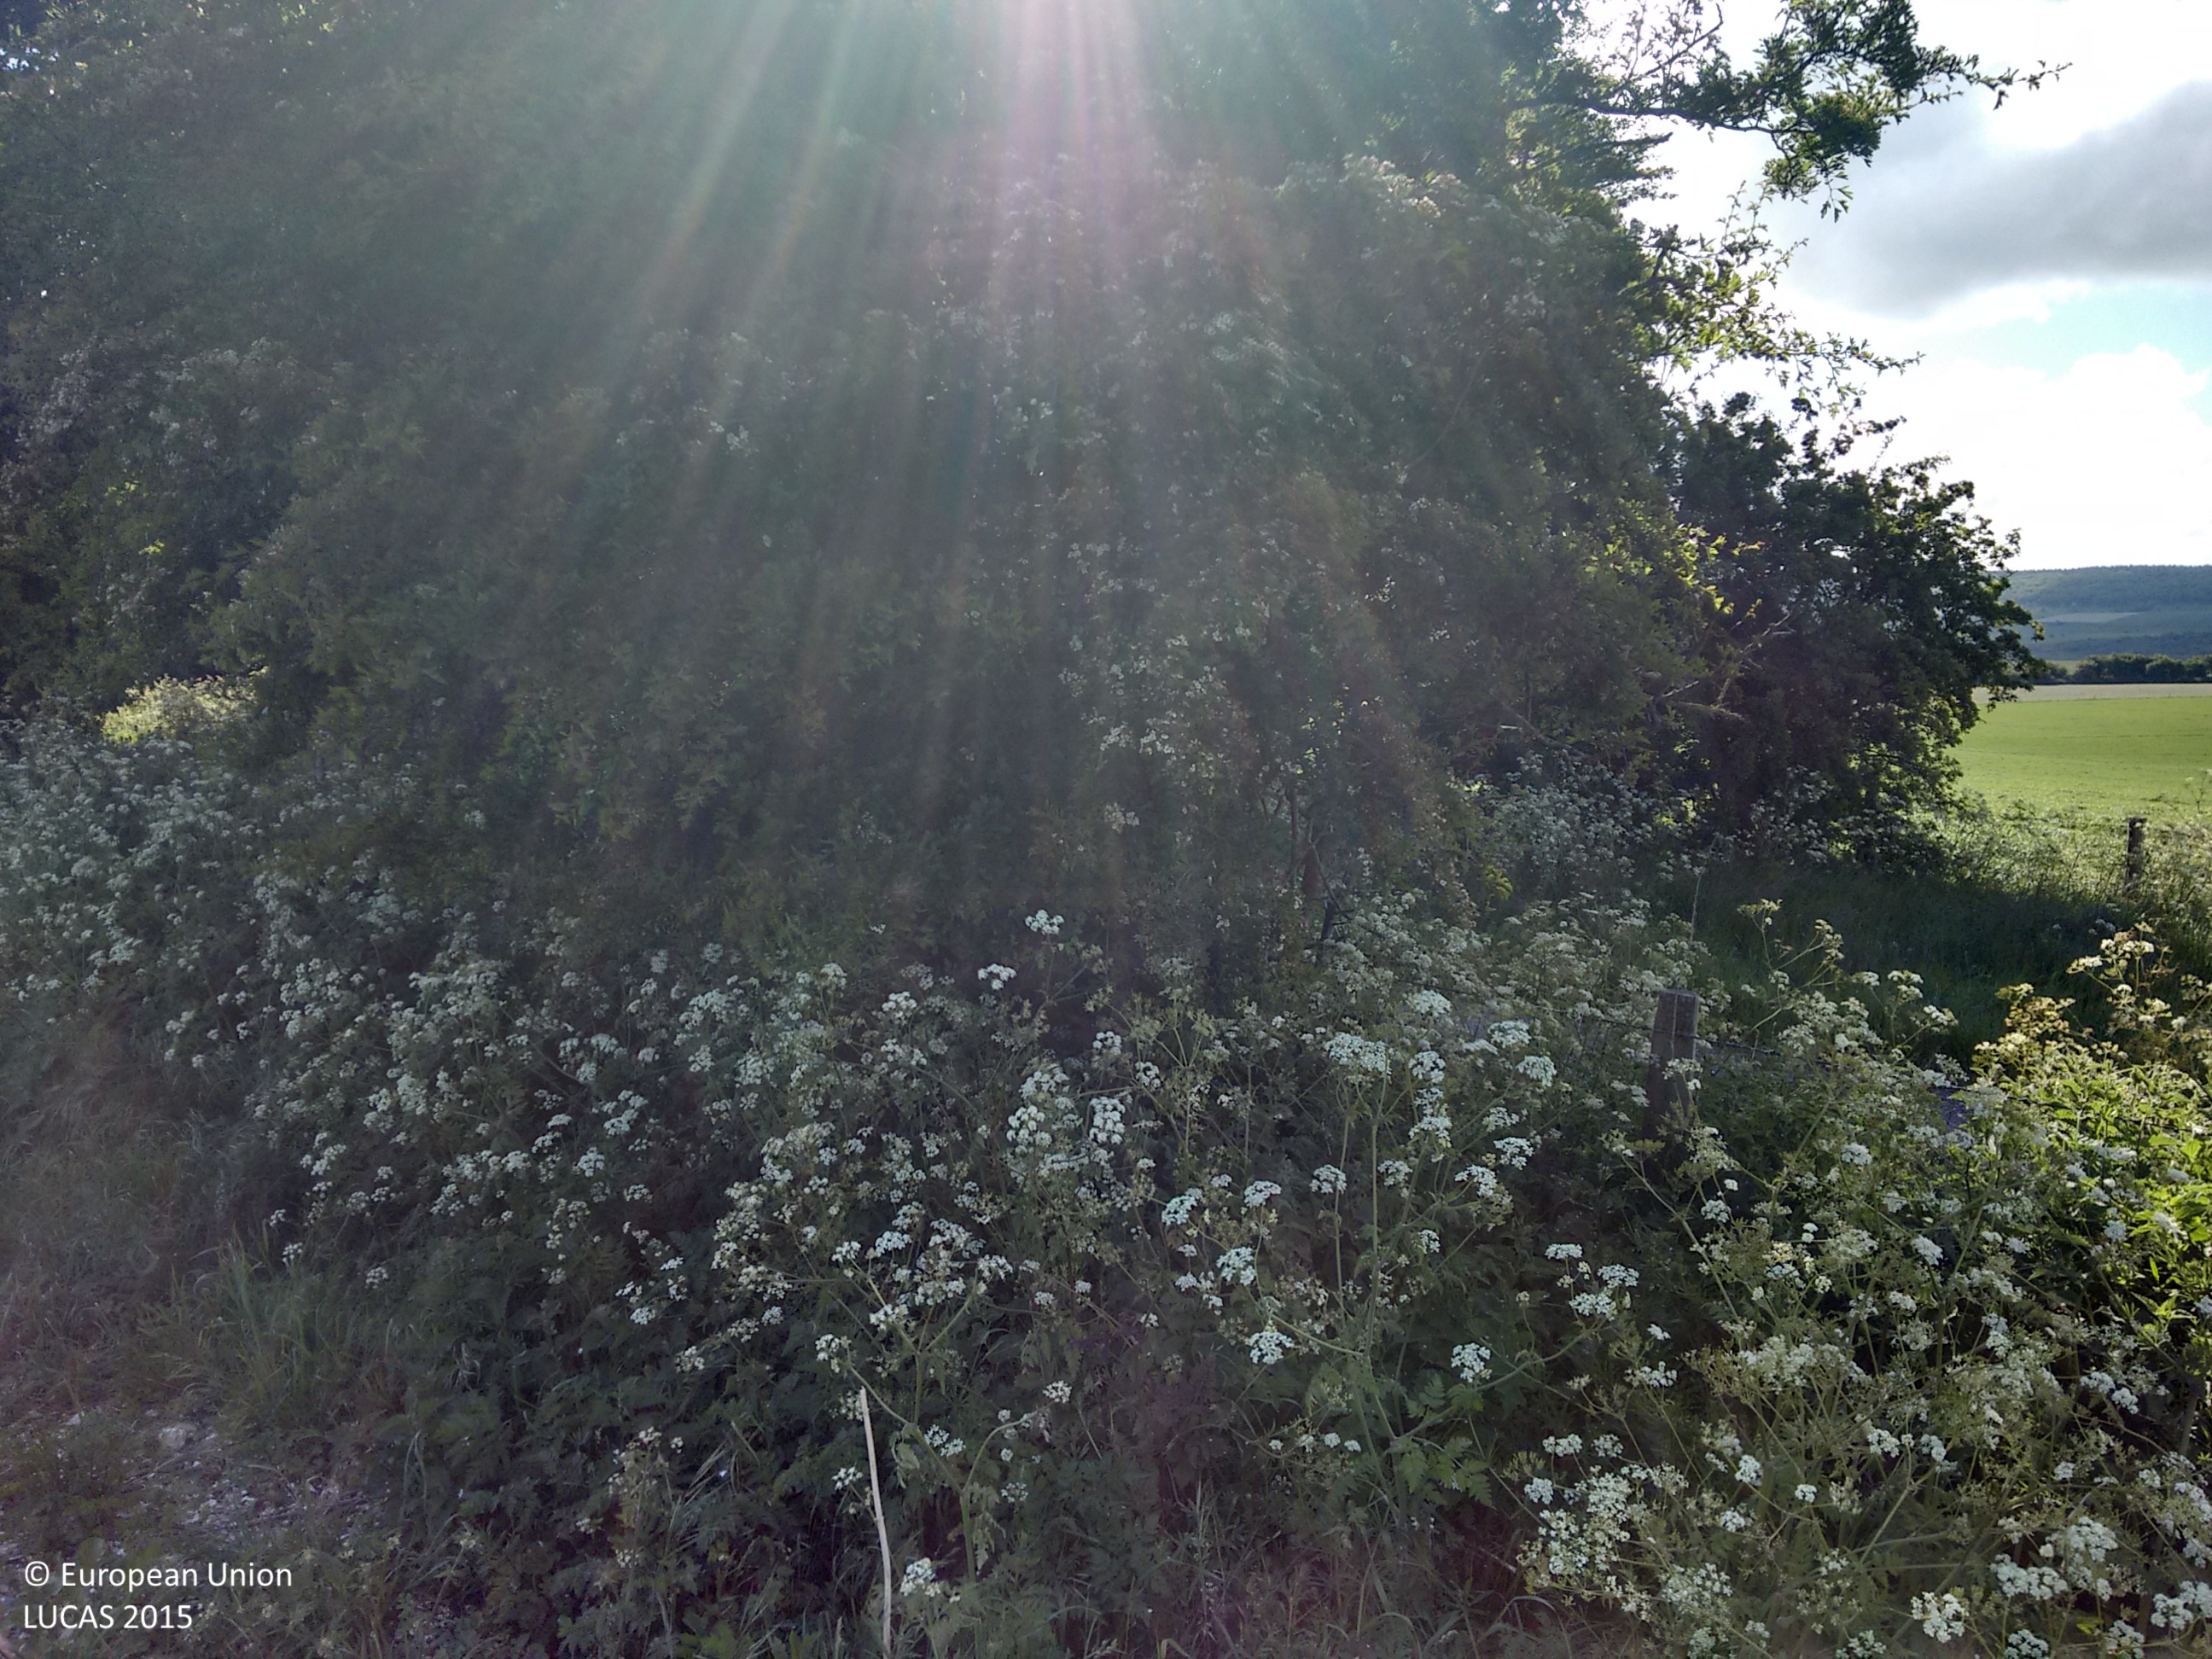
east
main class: Cropland
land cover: Common wheat
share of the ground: > 75 %
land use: Agriculture (excluding fallow land and kitchen gardens)
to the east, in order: Common wheat; Grass margins; Fences; Managed hedges; Grass margins; Paved roads, cycling and walking lanes; Grass margins; Lines of trees; Fences; Spontaneously vegetated surfaces; Barley
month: June
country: GB
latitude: 51.1513
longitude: -2.1410
